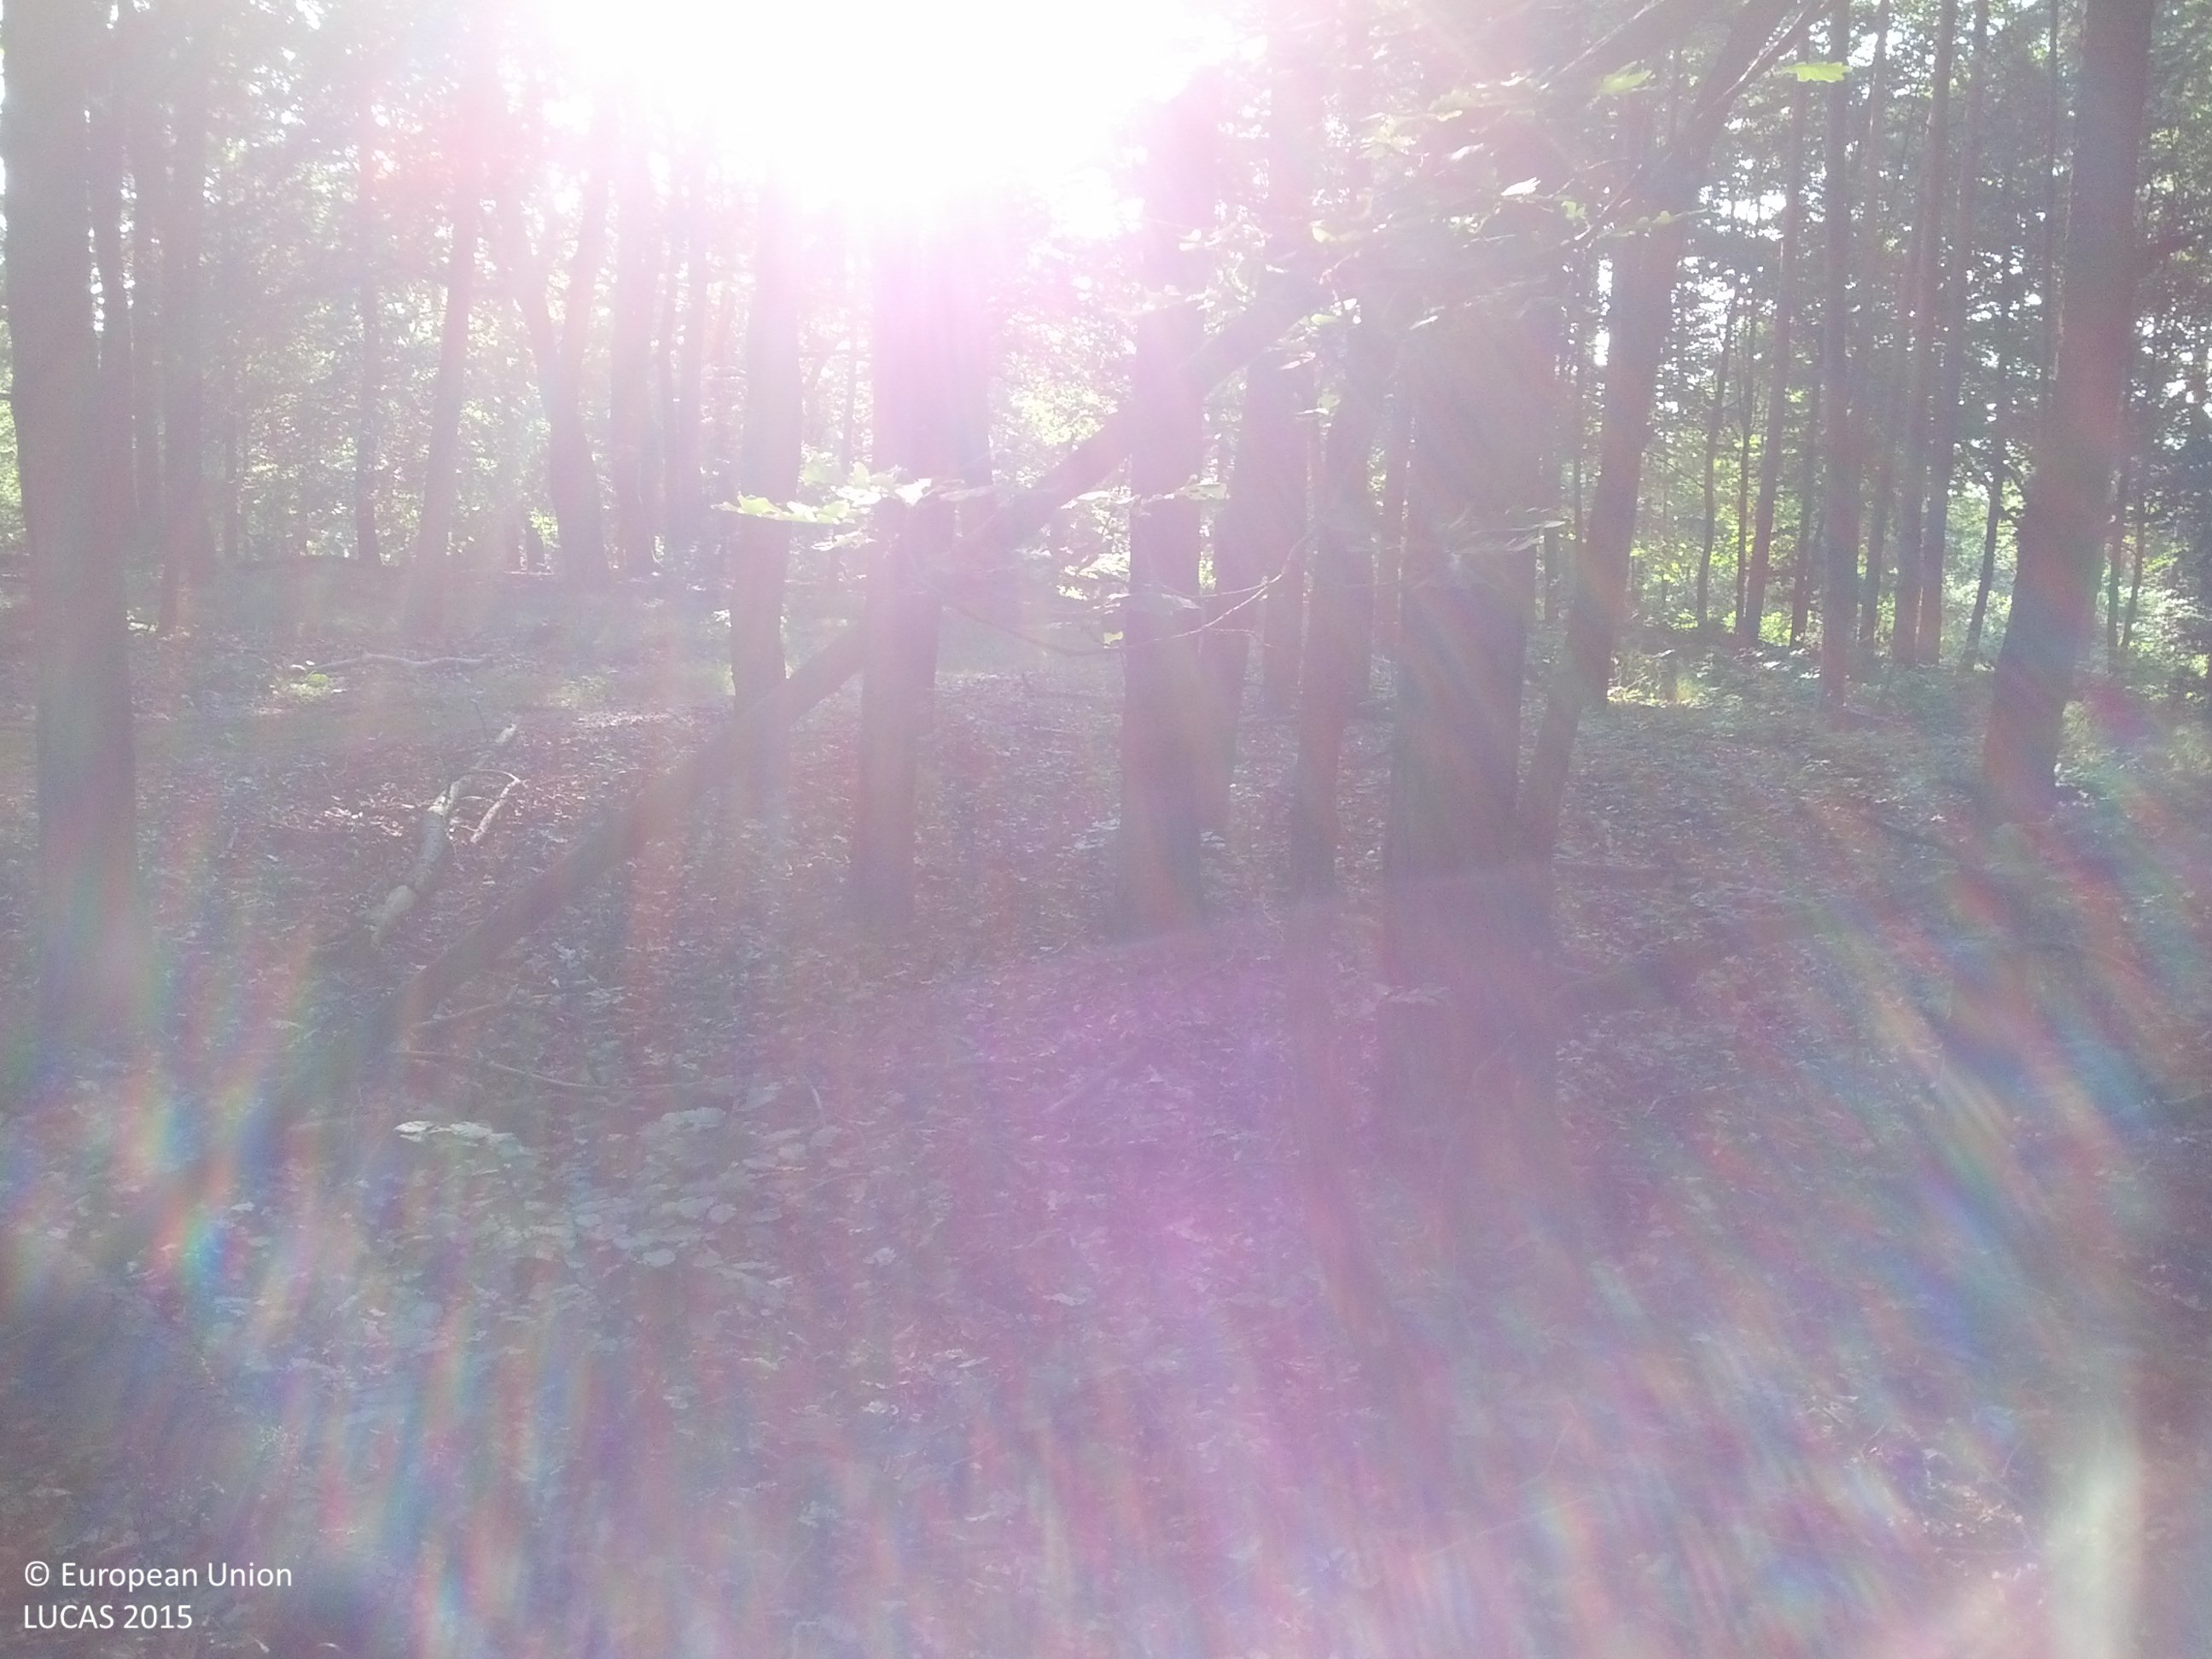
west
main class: Woodland
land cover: Pine dominated mixed woodland
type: hemiboreal forest and nemoral coniferous forest and mixed broadleaved-coniferous forest
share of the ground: 50 - 75 %
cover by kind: coniferous forest trees 50 %, broadleaved forest trees 30 %, herbaceous plants 20 %
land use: Forestry
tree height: > 5 m
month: June
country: AT
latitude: 47.0080
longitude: 16.4078
